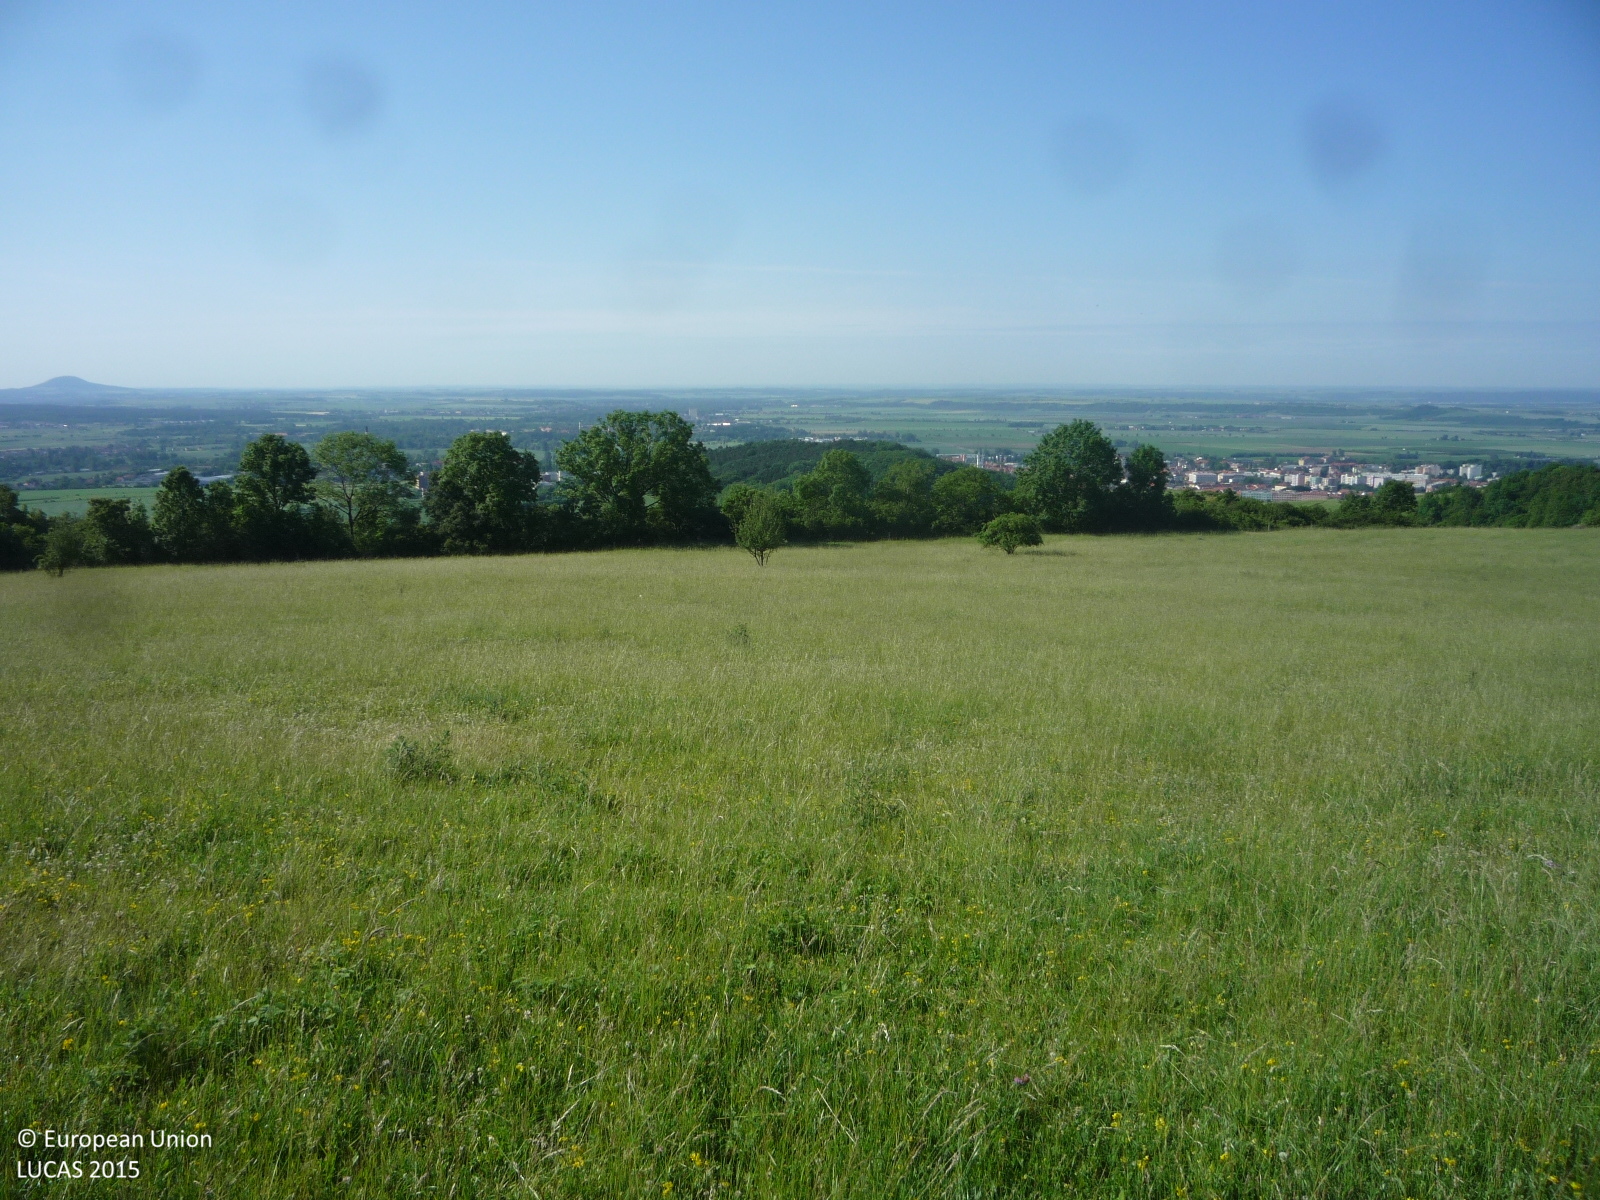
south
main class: Grassland
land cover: Grassland without tree/shrub cover
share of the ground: > 75 %
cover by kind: herbaceous plants 100 %
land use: Agriculture (excluding fallow land and kitchen gardens)
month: June
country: CZ
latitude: 50.5593
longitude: 14.1372
